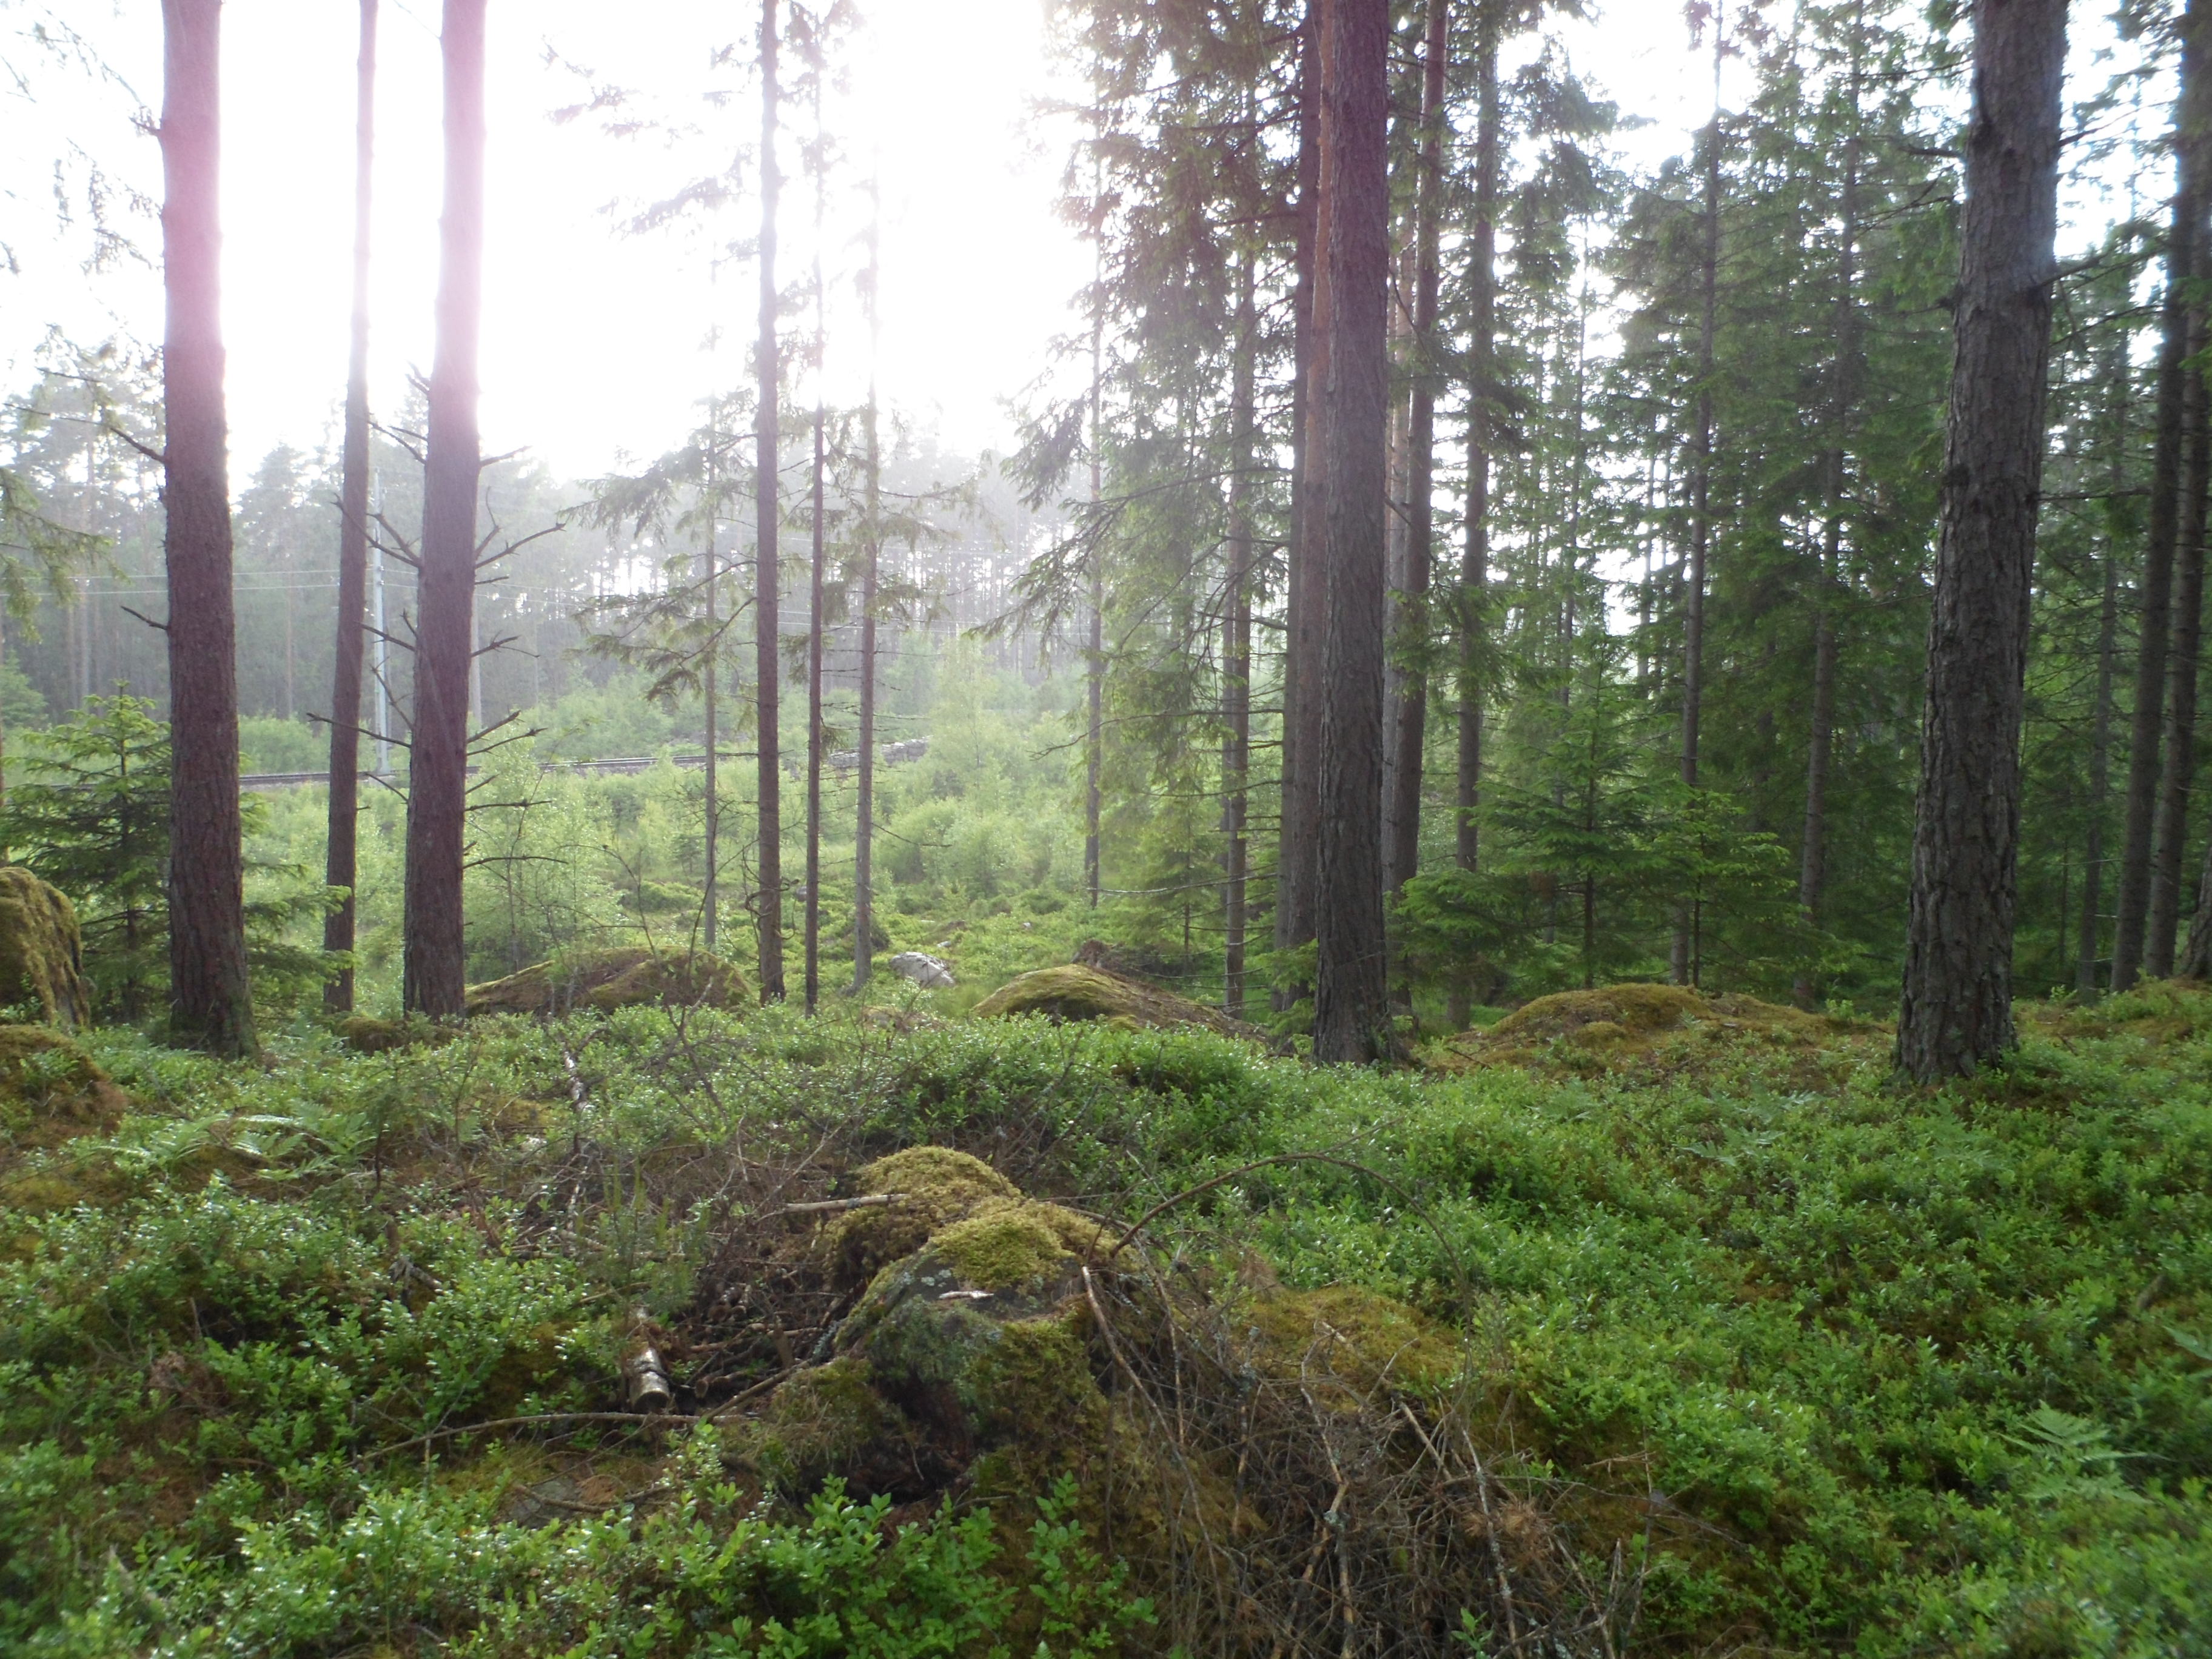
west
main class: Woodland
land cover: Spruce dominated coniferous woodland
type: boreal forest
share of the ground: 50 - 75 %
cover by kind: coniferous forest trees 55 %, shrubs 25 %, lichens and mosses 10 %, broadleaved forest trees 5 %, herbaceous plants 5 %
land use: Forestry
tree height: > 5 m
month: June
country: SE
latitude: 56.8795
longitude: 14.6080
